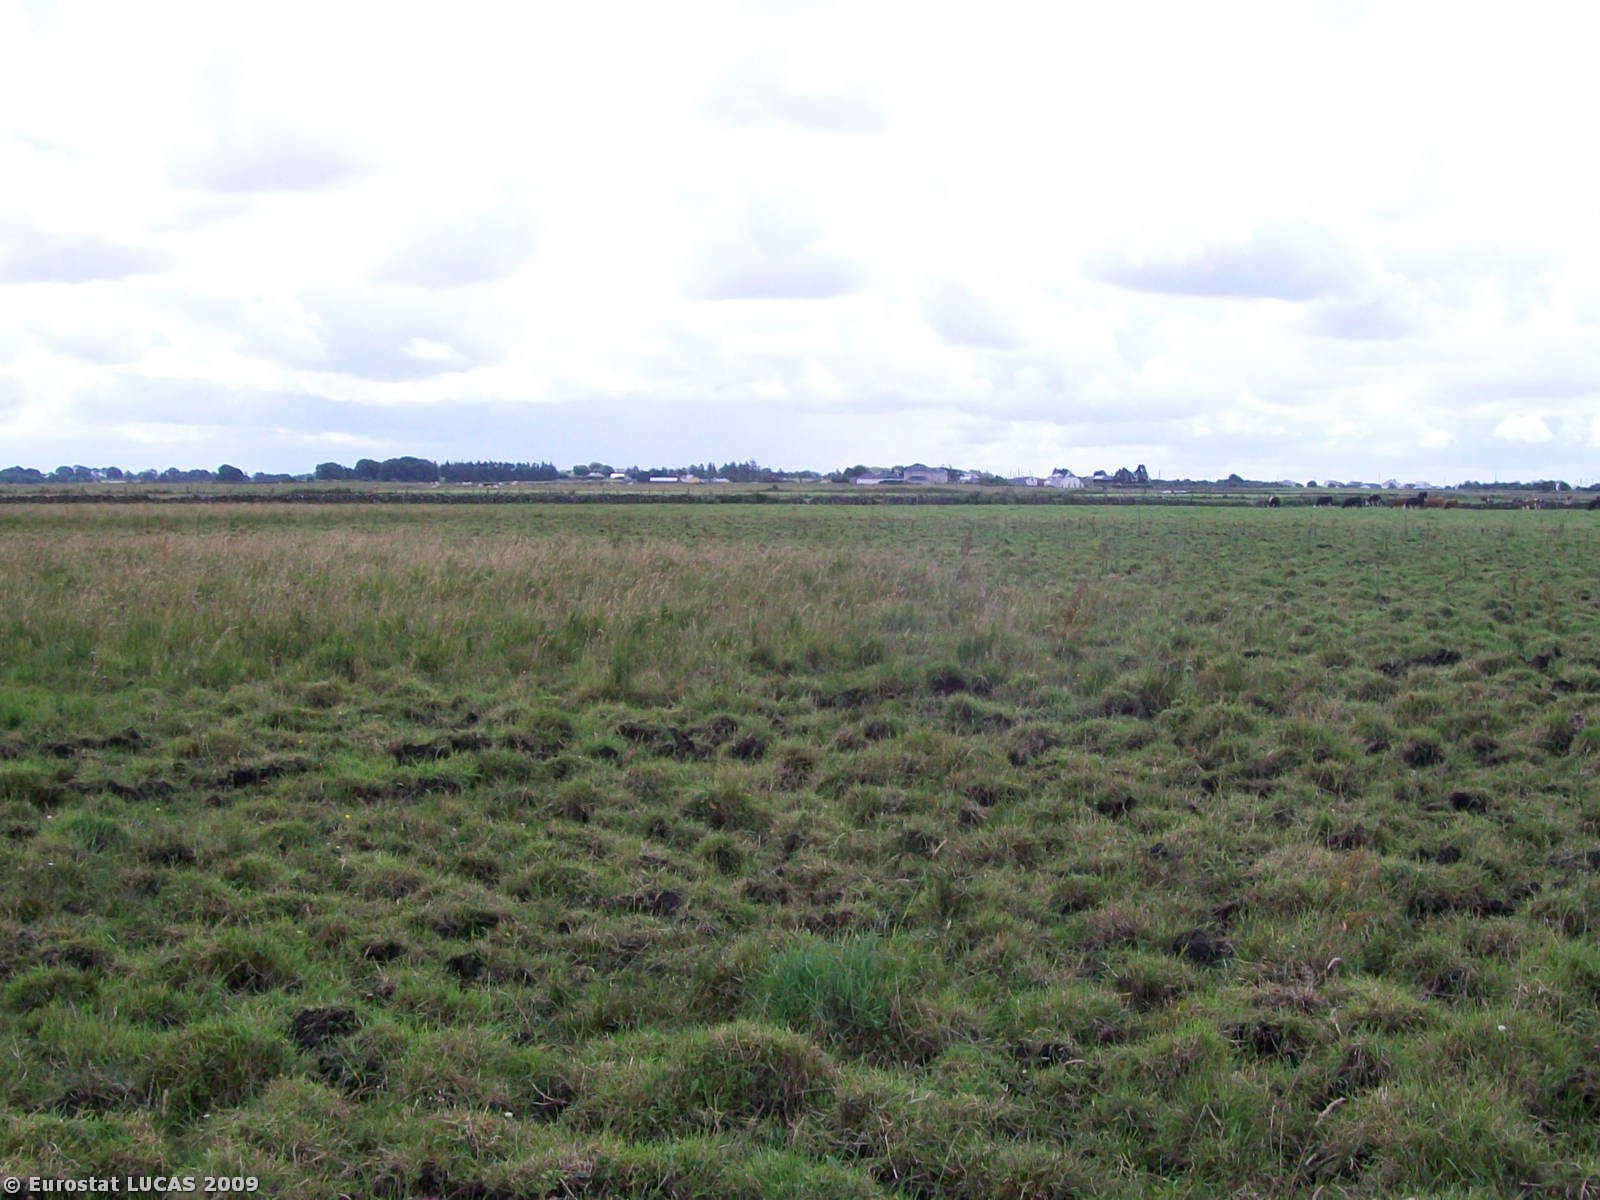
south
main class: Grassland
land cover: Grassland without tree/shrub cover
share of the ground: > 75 %
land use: Agriculture (excluding fallow land and kitchen gardens)
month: July
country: IE
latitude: 53.4701
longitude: -8.8728
